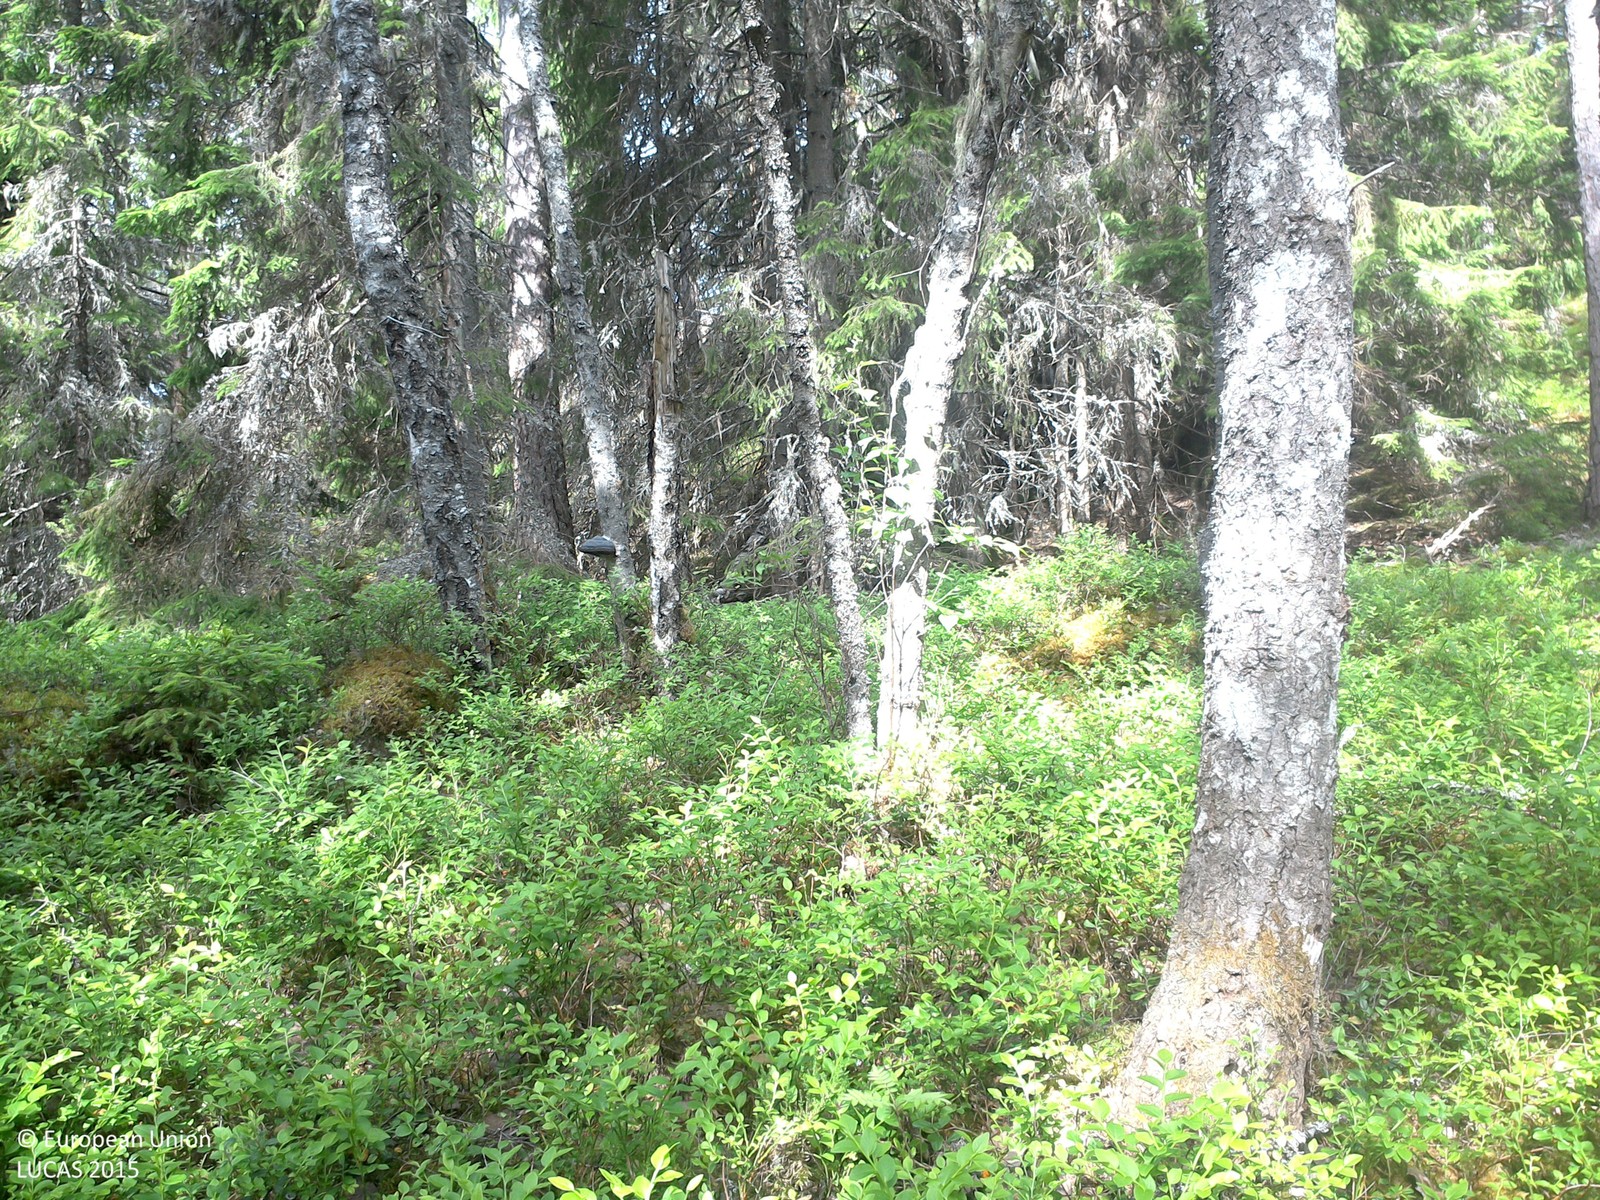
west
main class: Woodland
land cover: Spruce dominated coniferous woodland
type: boreal forest
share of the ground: 50 - 75 %
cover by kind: coniferous forest trees 60 %, lichens and mosses 20 %, herbaceous plants 15 %, broadleaved forest trees 5 %
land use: Forestry
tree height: > 5 m
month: June
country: SE
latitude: 58.1424
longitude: 15.5159
